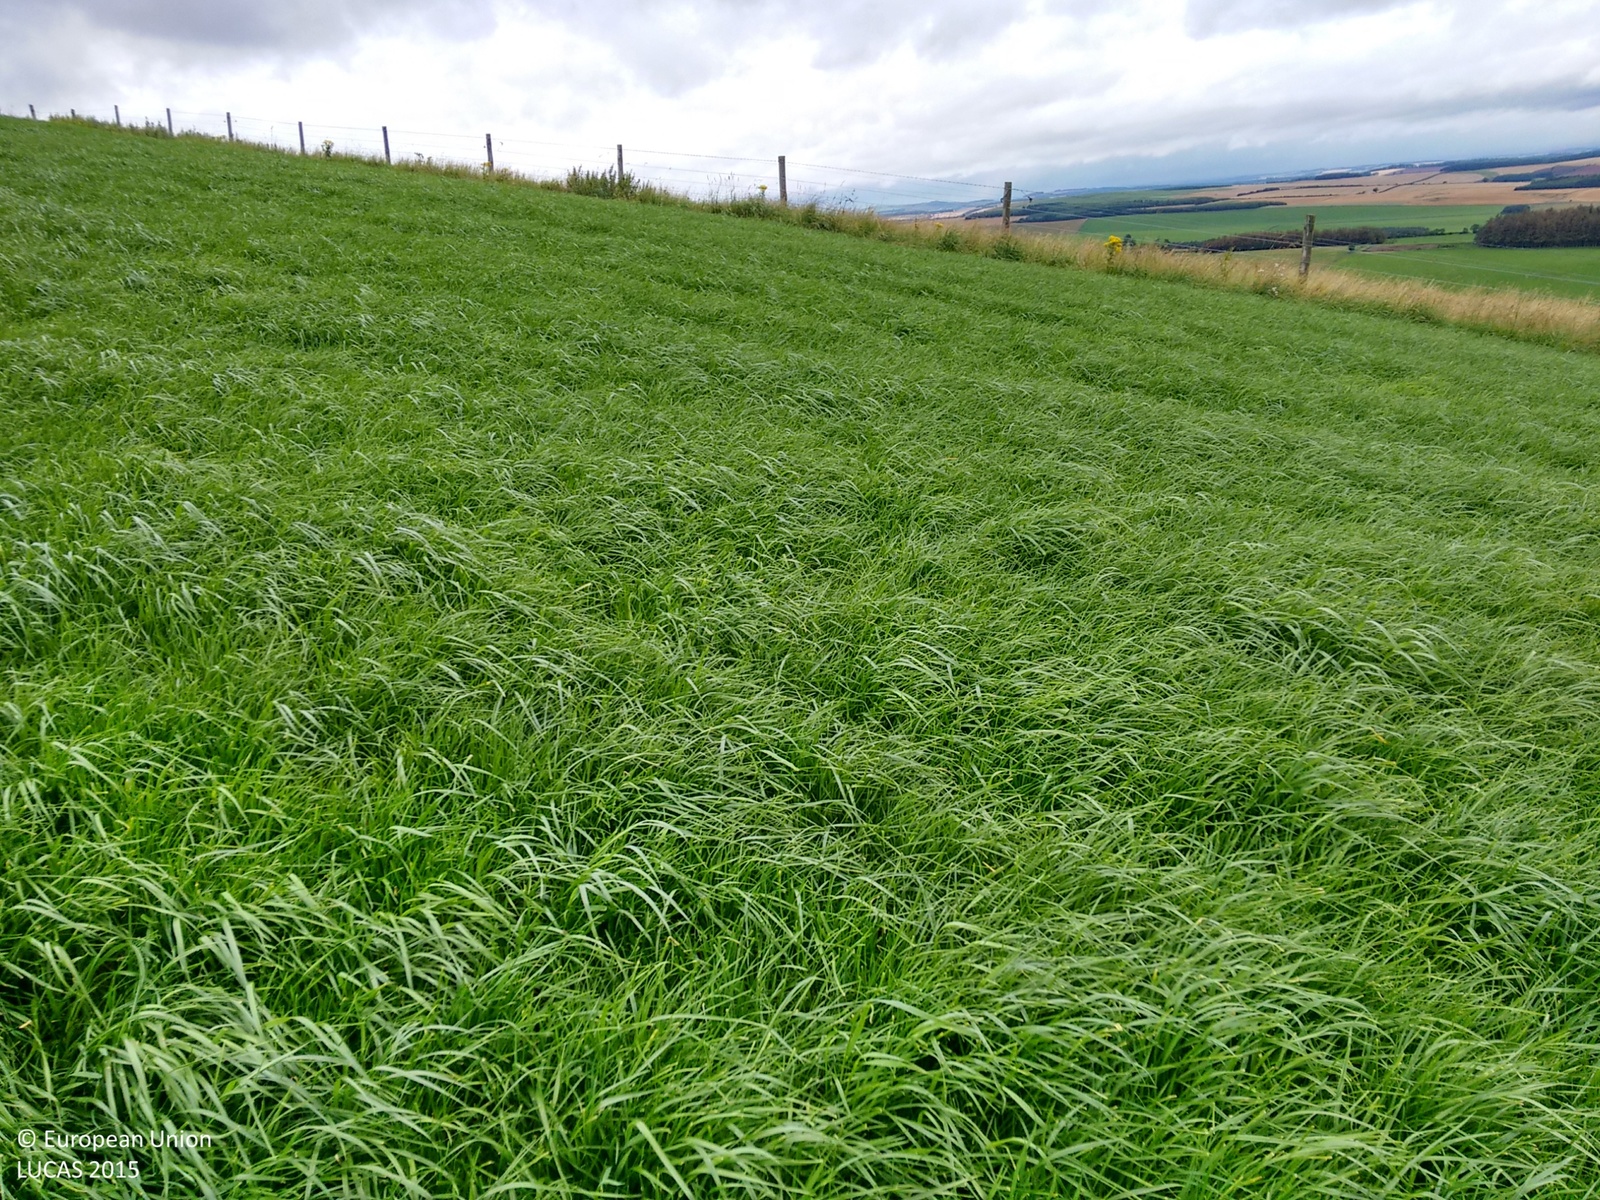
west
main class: Cropland
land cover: Temporary grasslands
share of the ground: > 75 %
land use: Agriculture (excluding fallow land and kitchen gardens)
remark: Harvested field
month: August
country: GB
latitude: 55.4965
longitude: -2.3581
